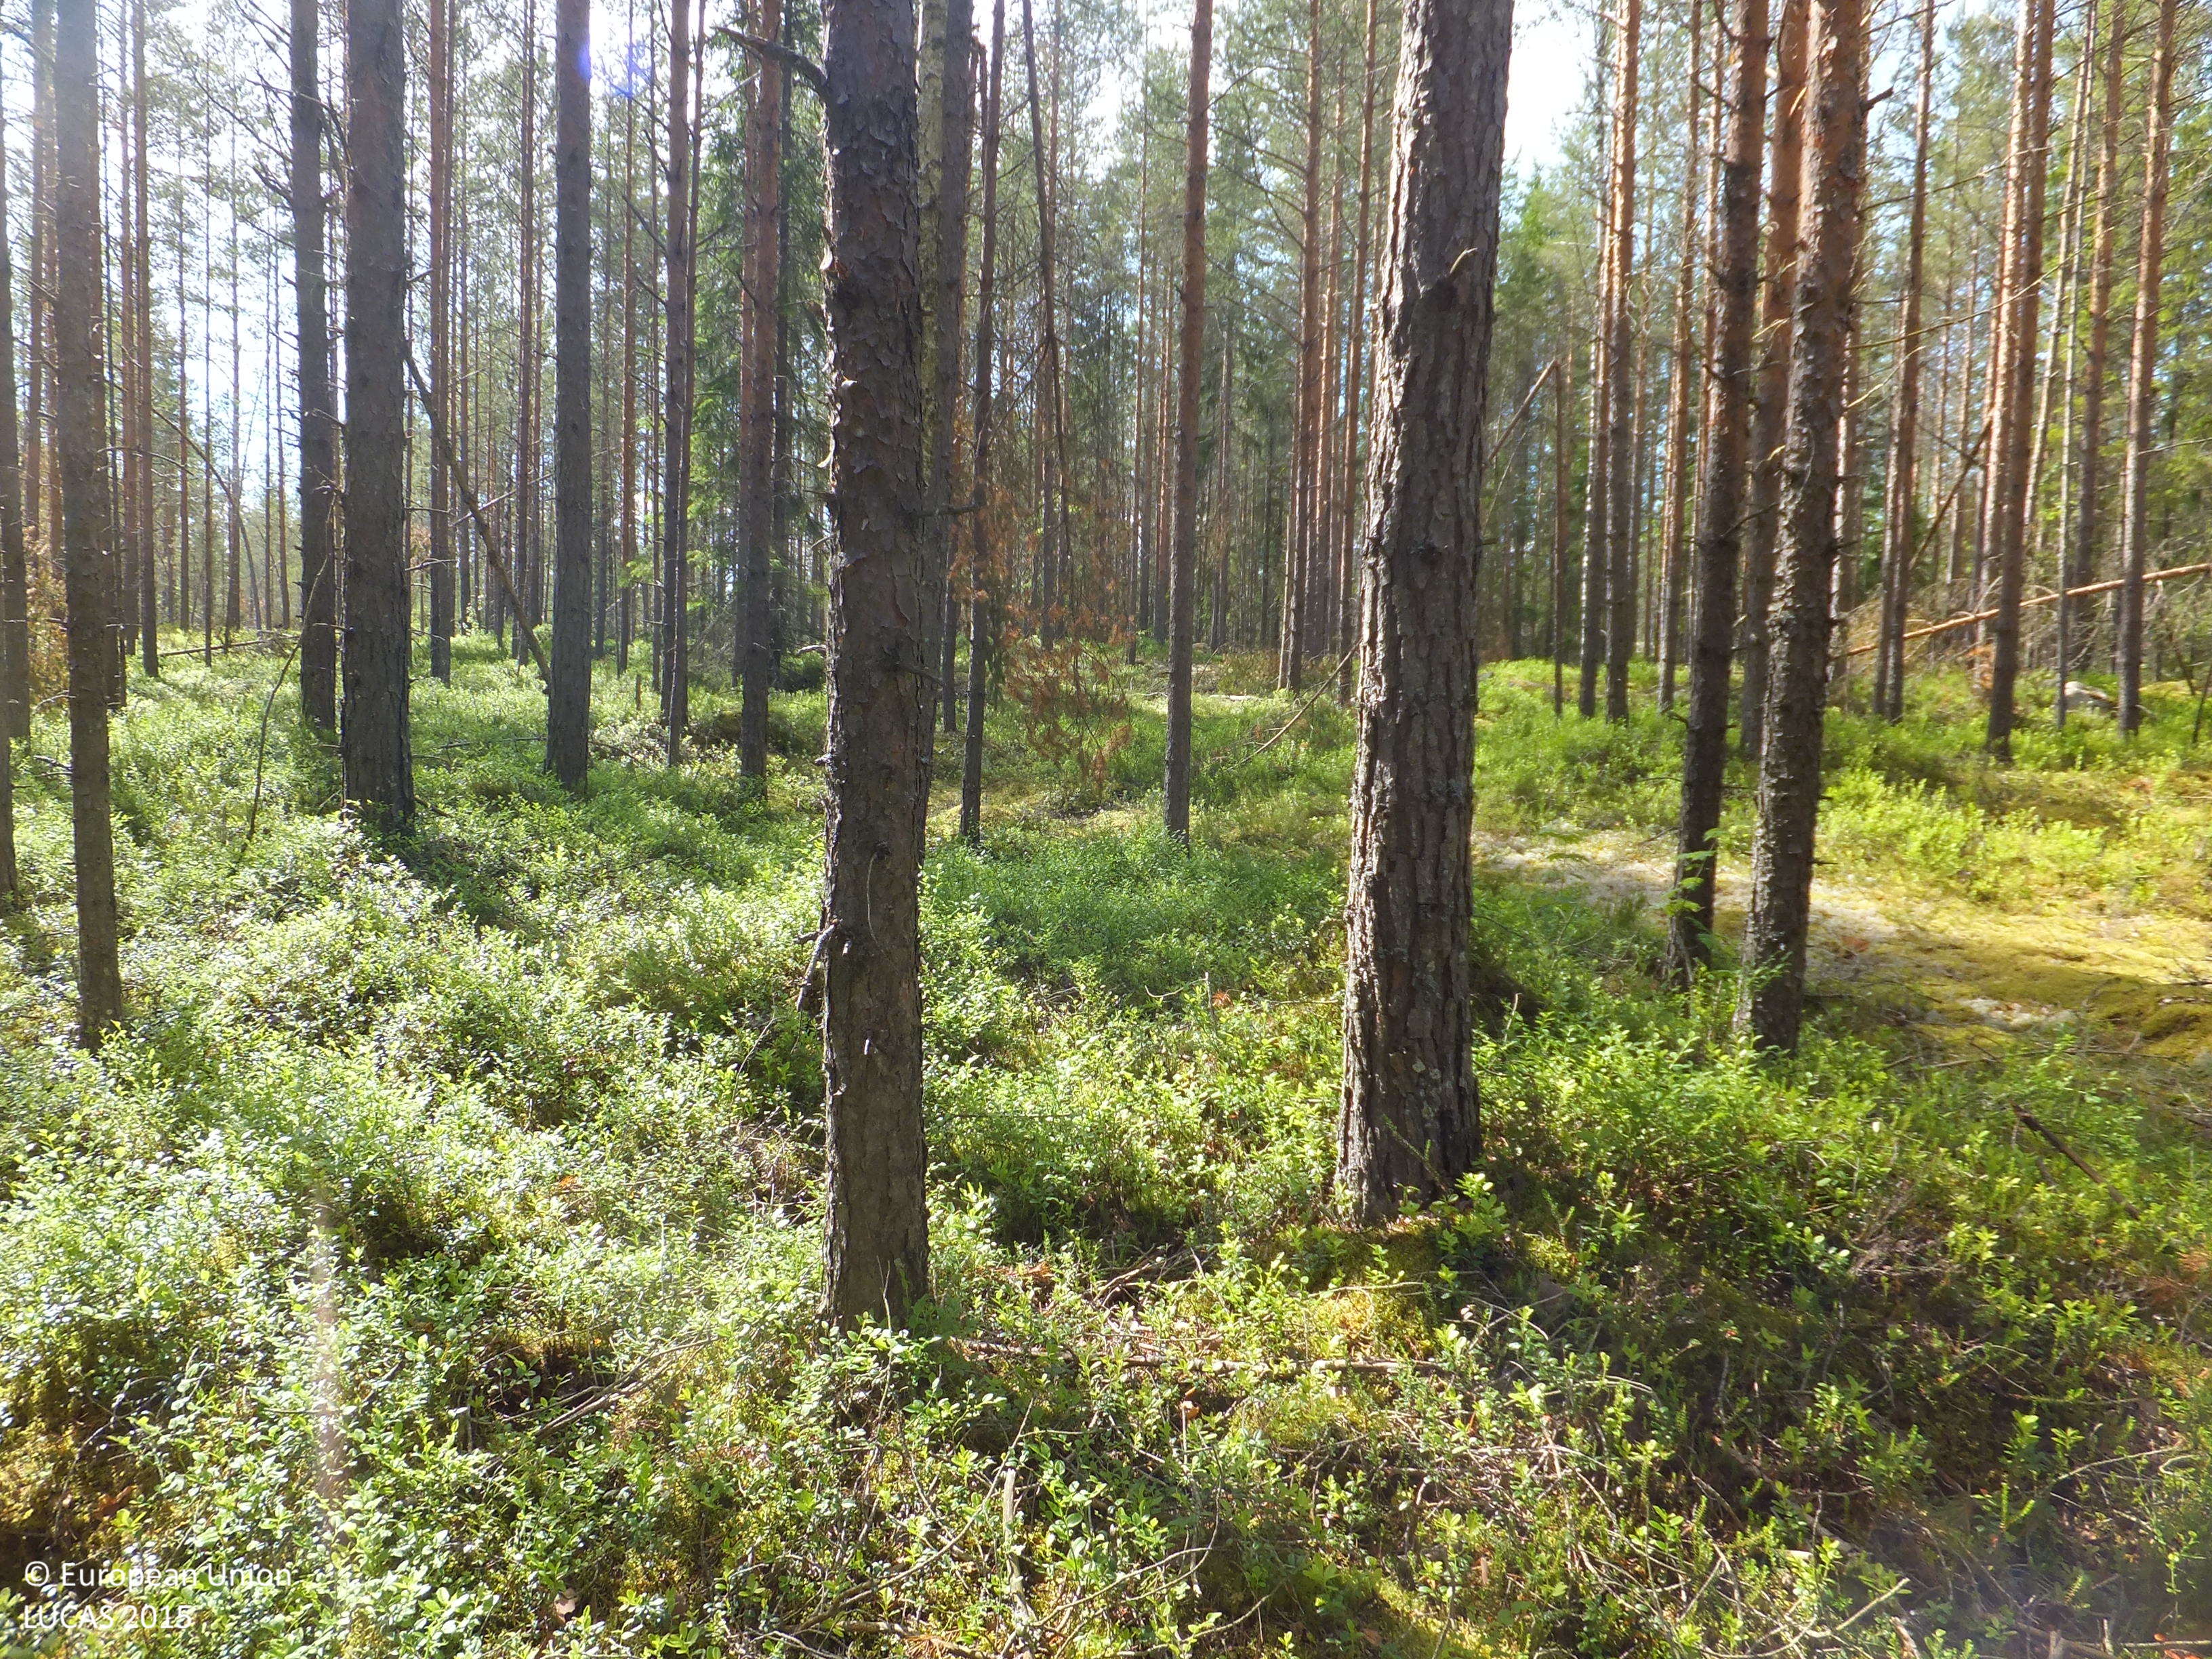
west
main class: Woodland
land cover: Pine dominated coniferous woodland
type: boreal forest
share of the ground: > 75 %
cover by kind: coniferous forest trees 75 %, shrubs 10 %, lichens and mosses 10 %, broadleaved forest trees 5 %
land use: Forestry
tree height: > 5 m
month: July
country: FI
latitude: 63.0791
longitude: 23.9516
